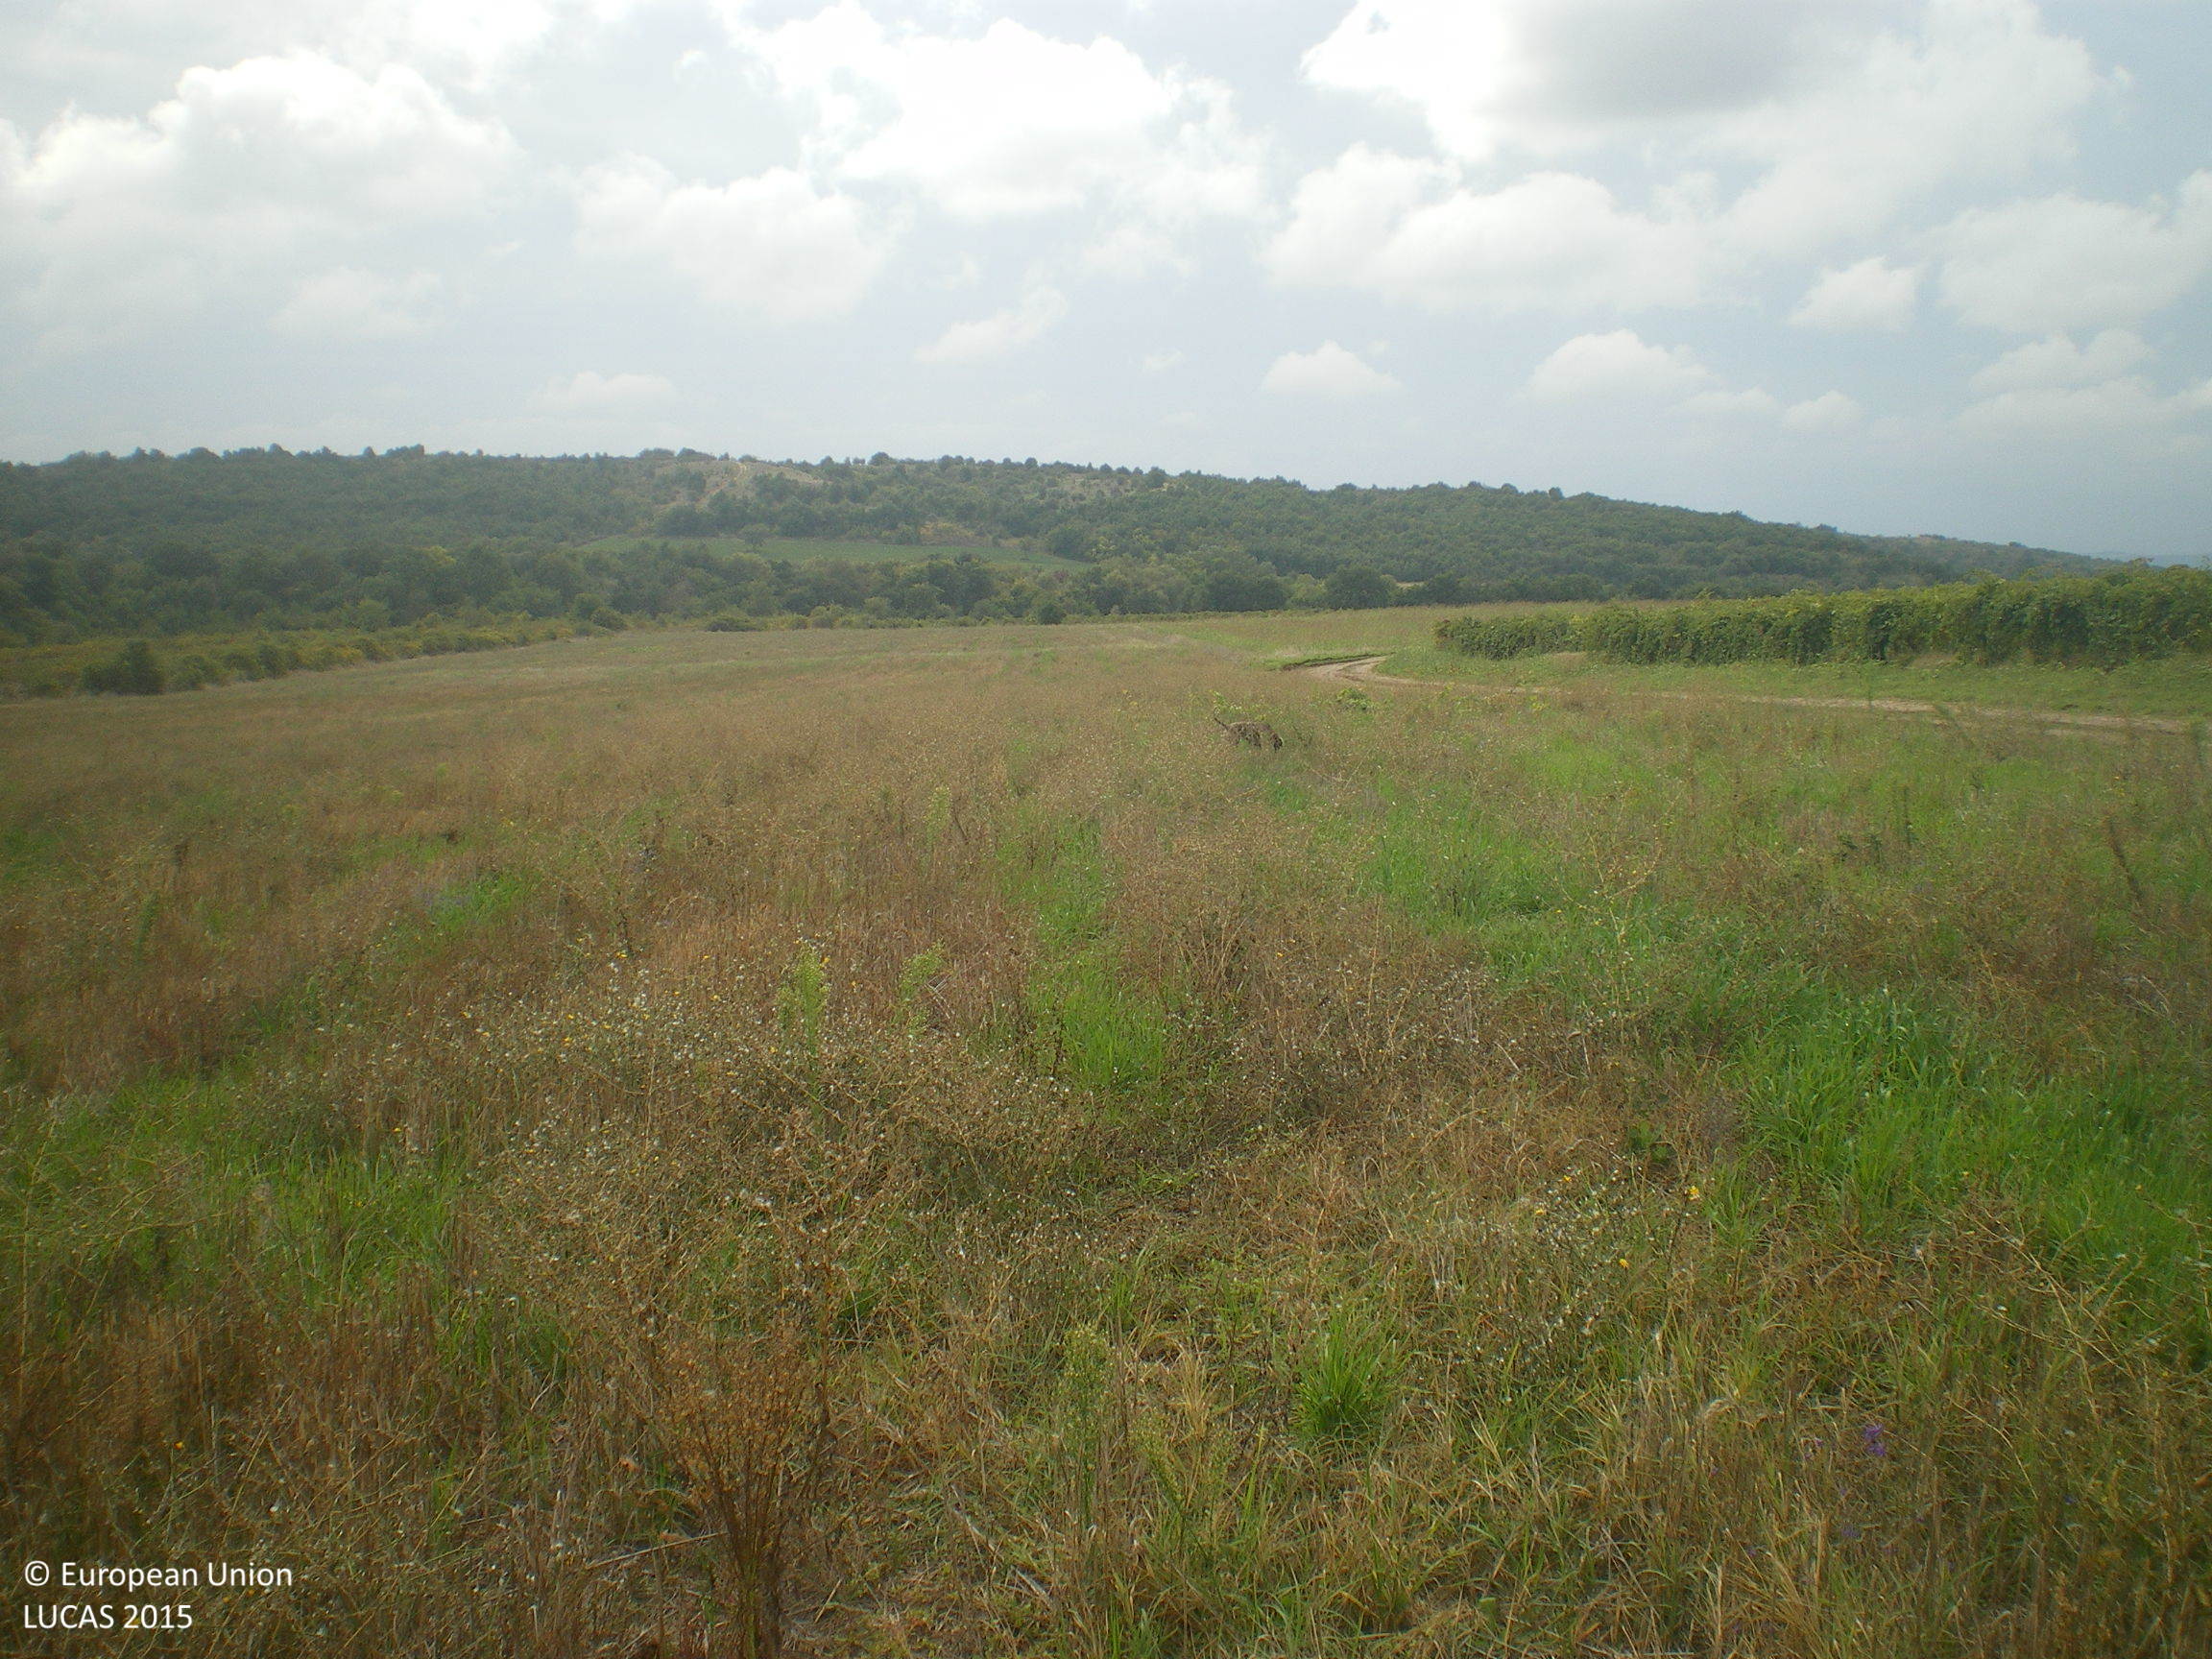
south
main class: Cropland
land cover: Common wheat
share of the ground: < 10 %
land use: Agriculture (excluding fallow land and kitchen gardens)
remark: Harvested field
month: October
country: BG
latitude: 41.9509
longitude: 26.0593
